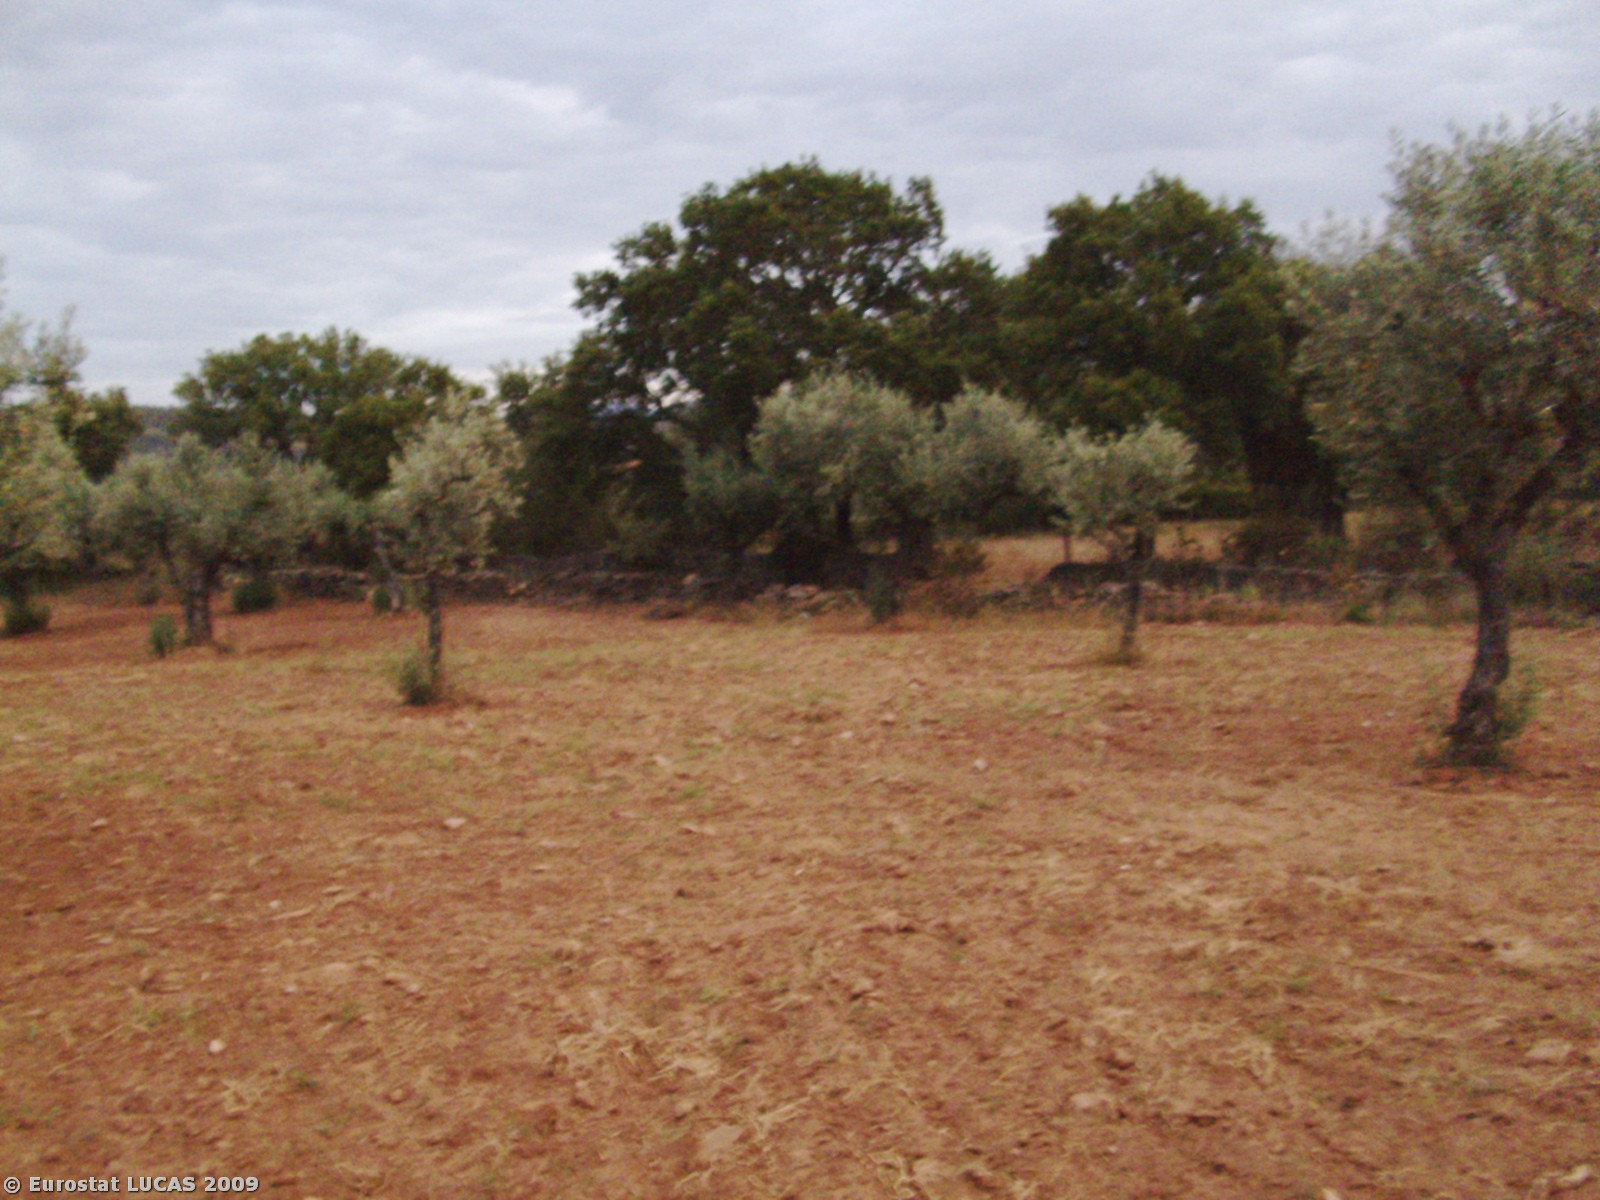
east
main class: Cropland
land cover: Olive groves
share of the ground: 50 - 75 %
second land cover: Bare land
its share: 25 - 50 %
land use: Agriculture (excluding fallow land and kitchen gardens)
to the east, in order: Olive groves; Bare land; Olive groves; Dry stone walls; Tracks; Dry stone walls; Olive groves; Fences; Shrubland with sparse tree cover
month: June
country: PT
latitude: 39.9229
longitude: -7.5710
